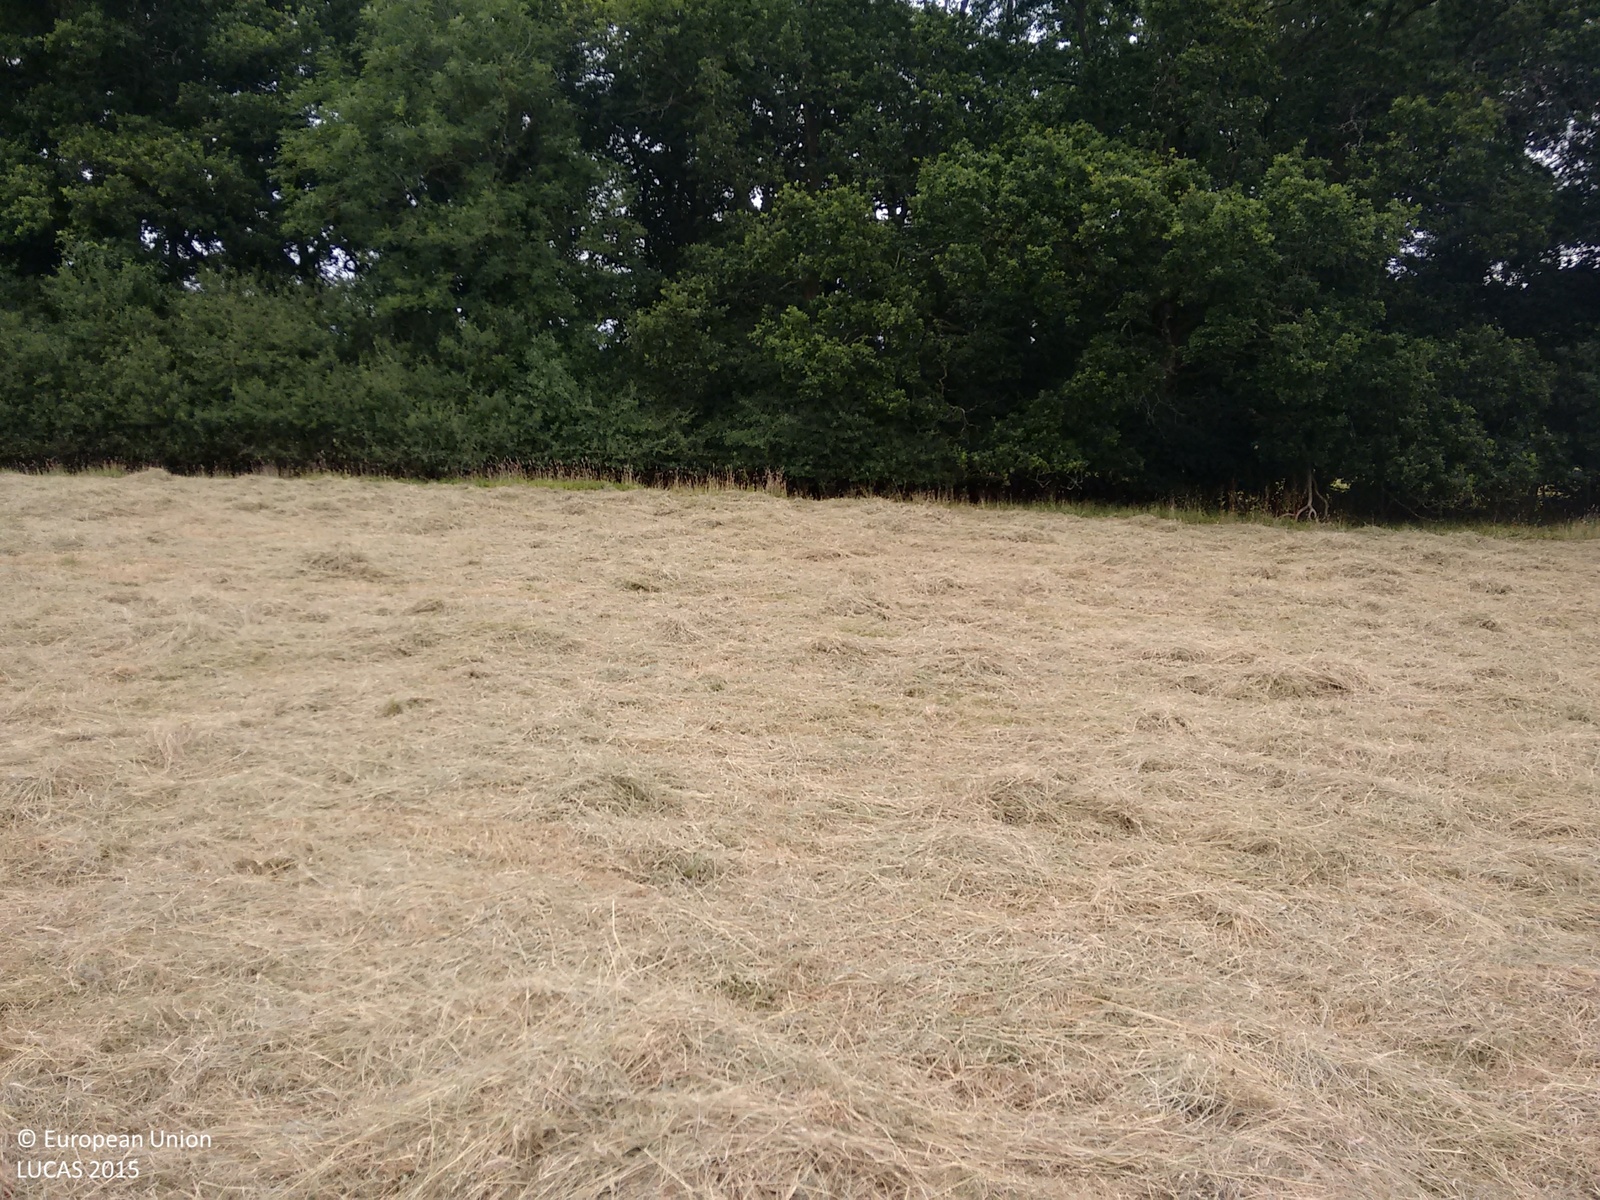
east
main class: Grassland
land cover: Grassland without tree/shrub cover
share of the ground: > 75 %
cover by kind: herbaceous plants 100 %
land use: Agriculture (excluding fallow land and kitchen gardens)
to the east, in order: Grassland without tree/shrub cover; Fences; Broadleaved woodland; Grass margins; Fences; Grassland without tree/shrub cover; Broadleaved woodland; Inland fresh running water; Grassland without tree/shrub cover
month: July
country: GB
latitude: 51.0788
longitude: -0.4723
